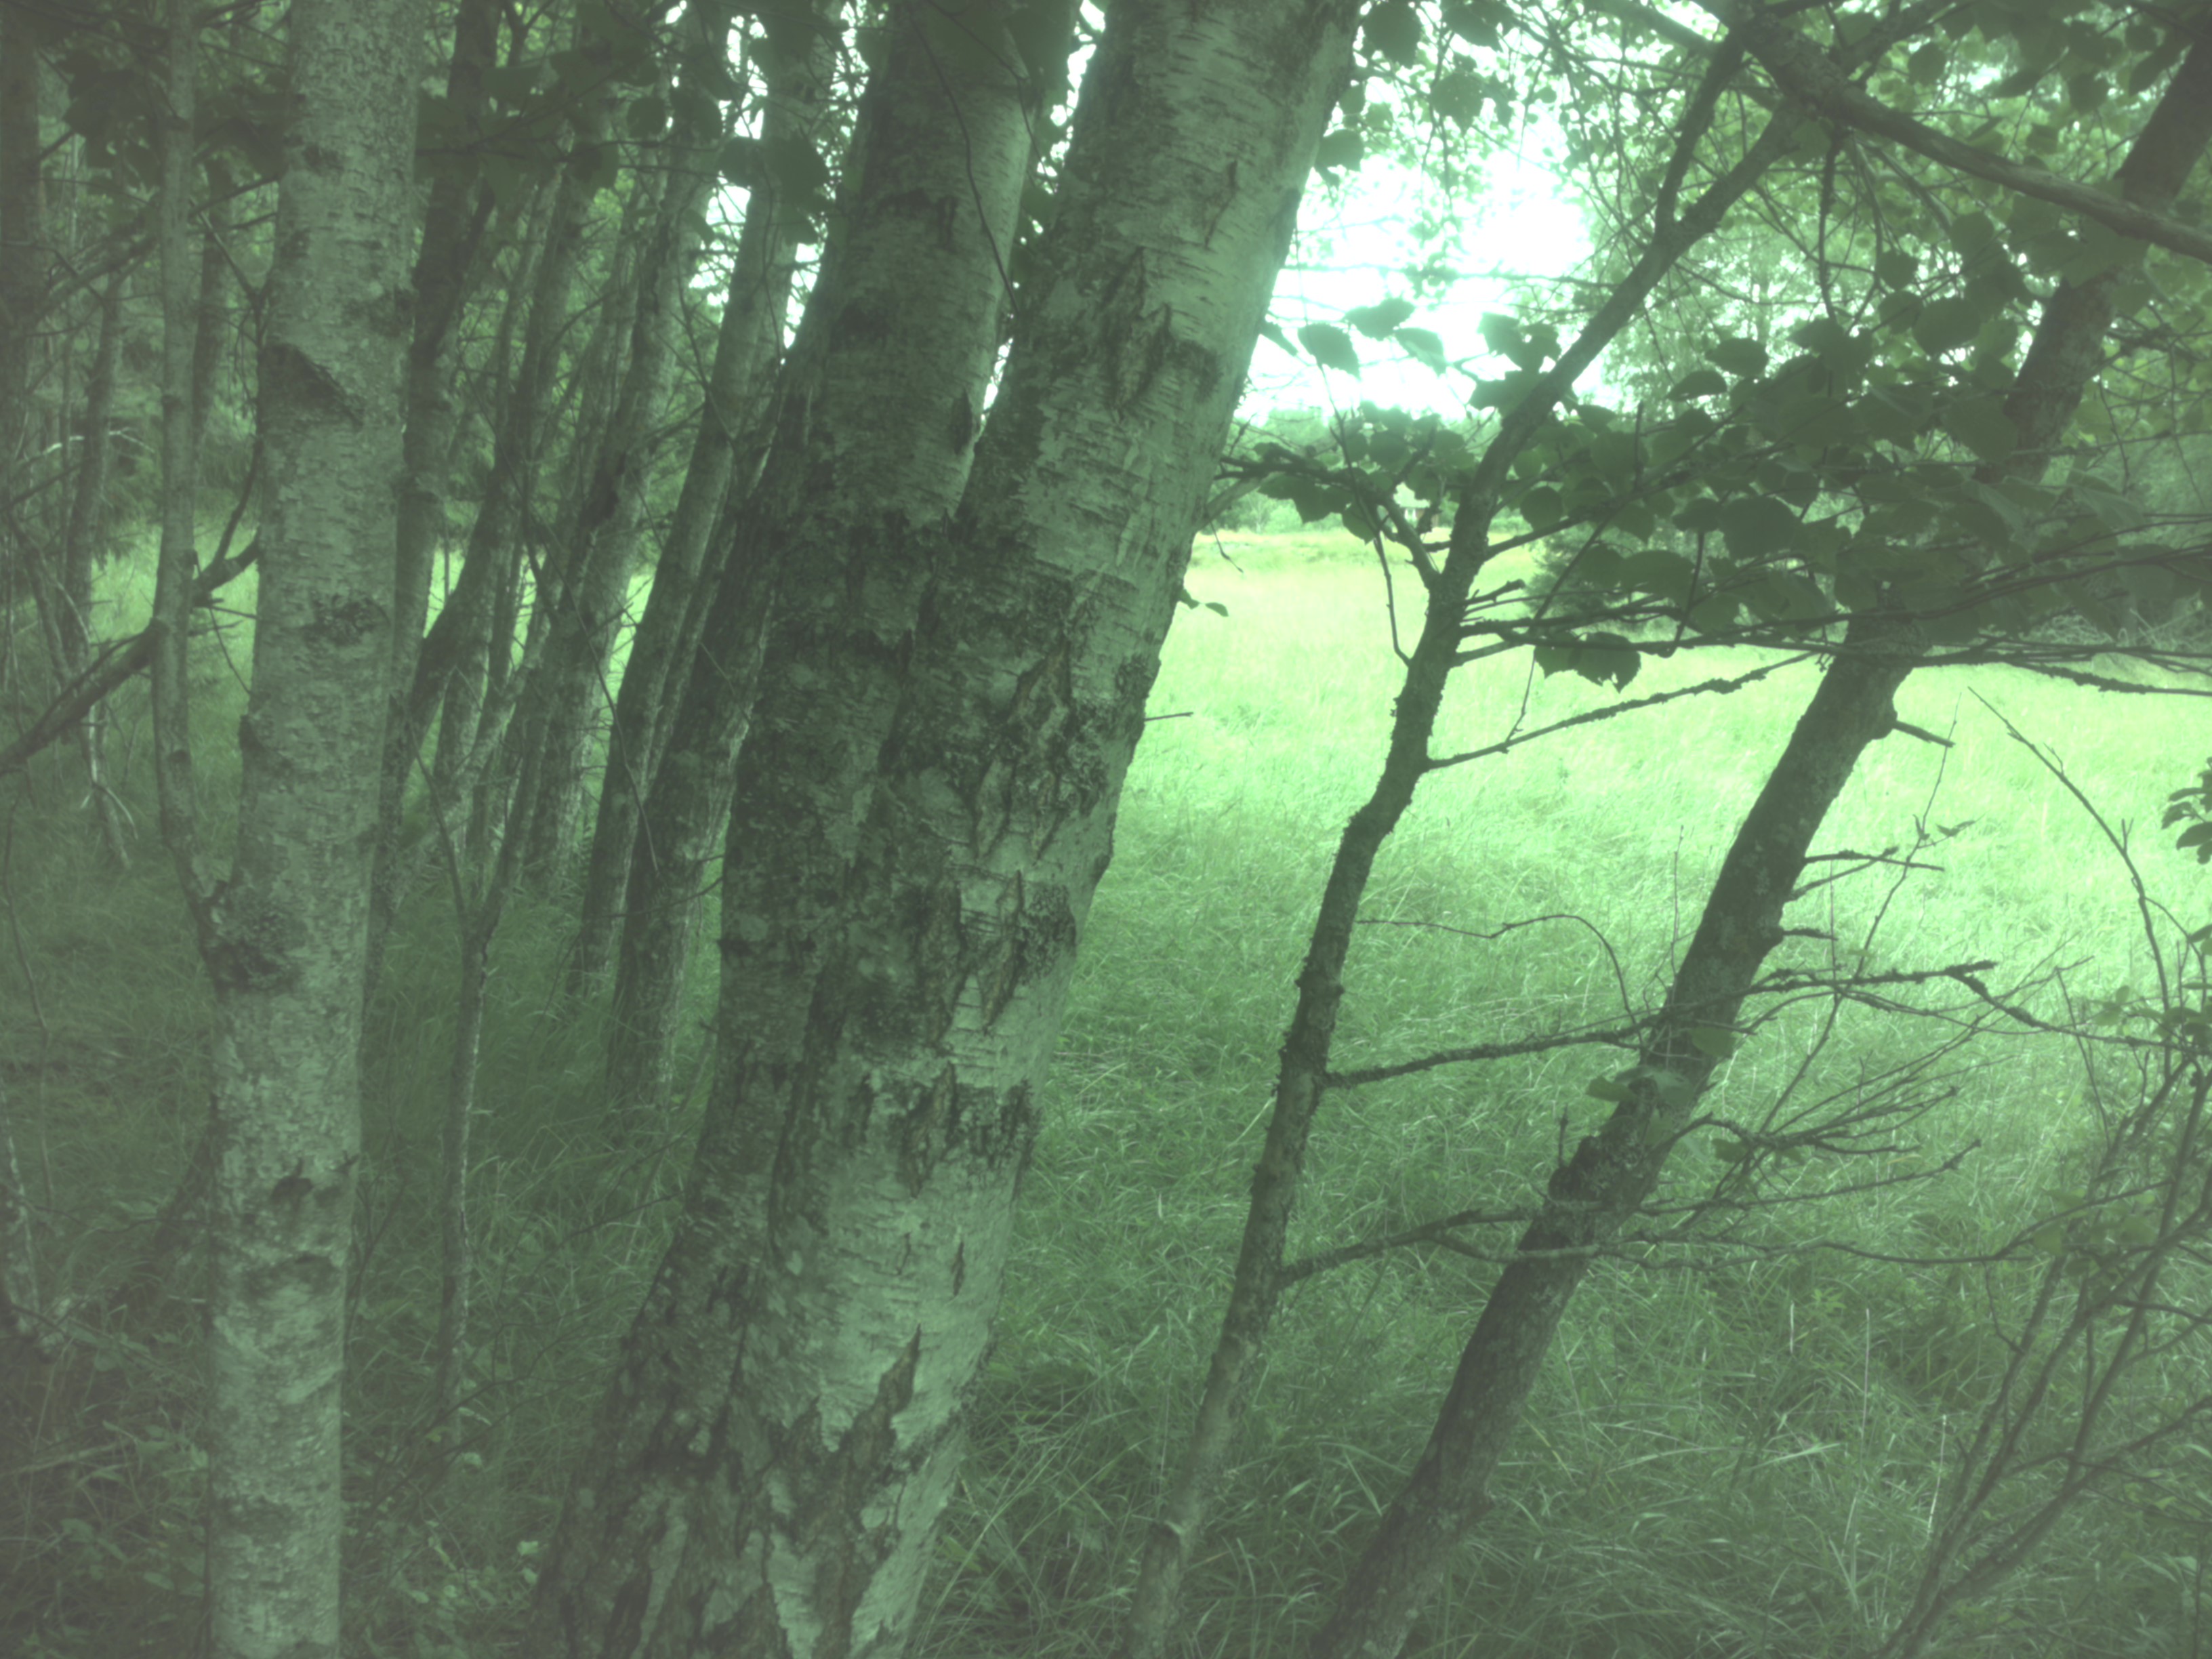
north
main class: Woodland
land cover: Broadleaved woodland
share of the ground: > 75 %
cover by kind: broadleaved forest trees 90 %, herbaceous plants 5 %, lichens and mosses 5 %
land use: Amenities, museums, leisure
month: July
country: SE
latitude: 59.2124
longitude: 18.2851
